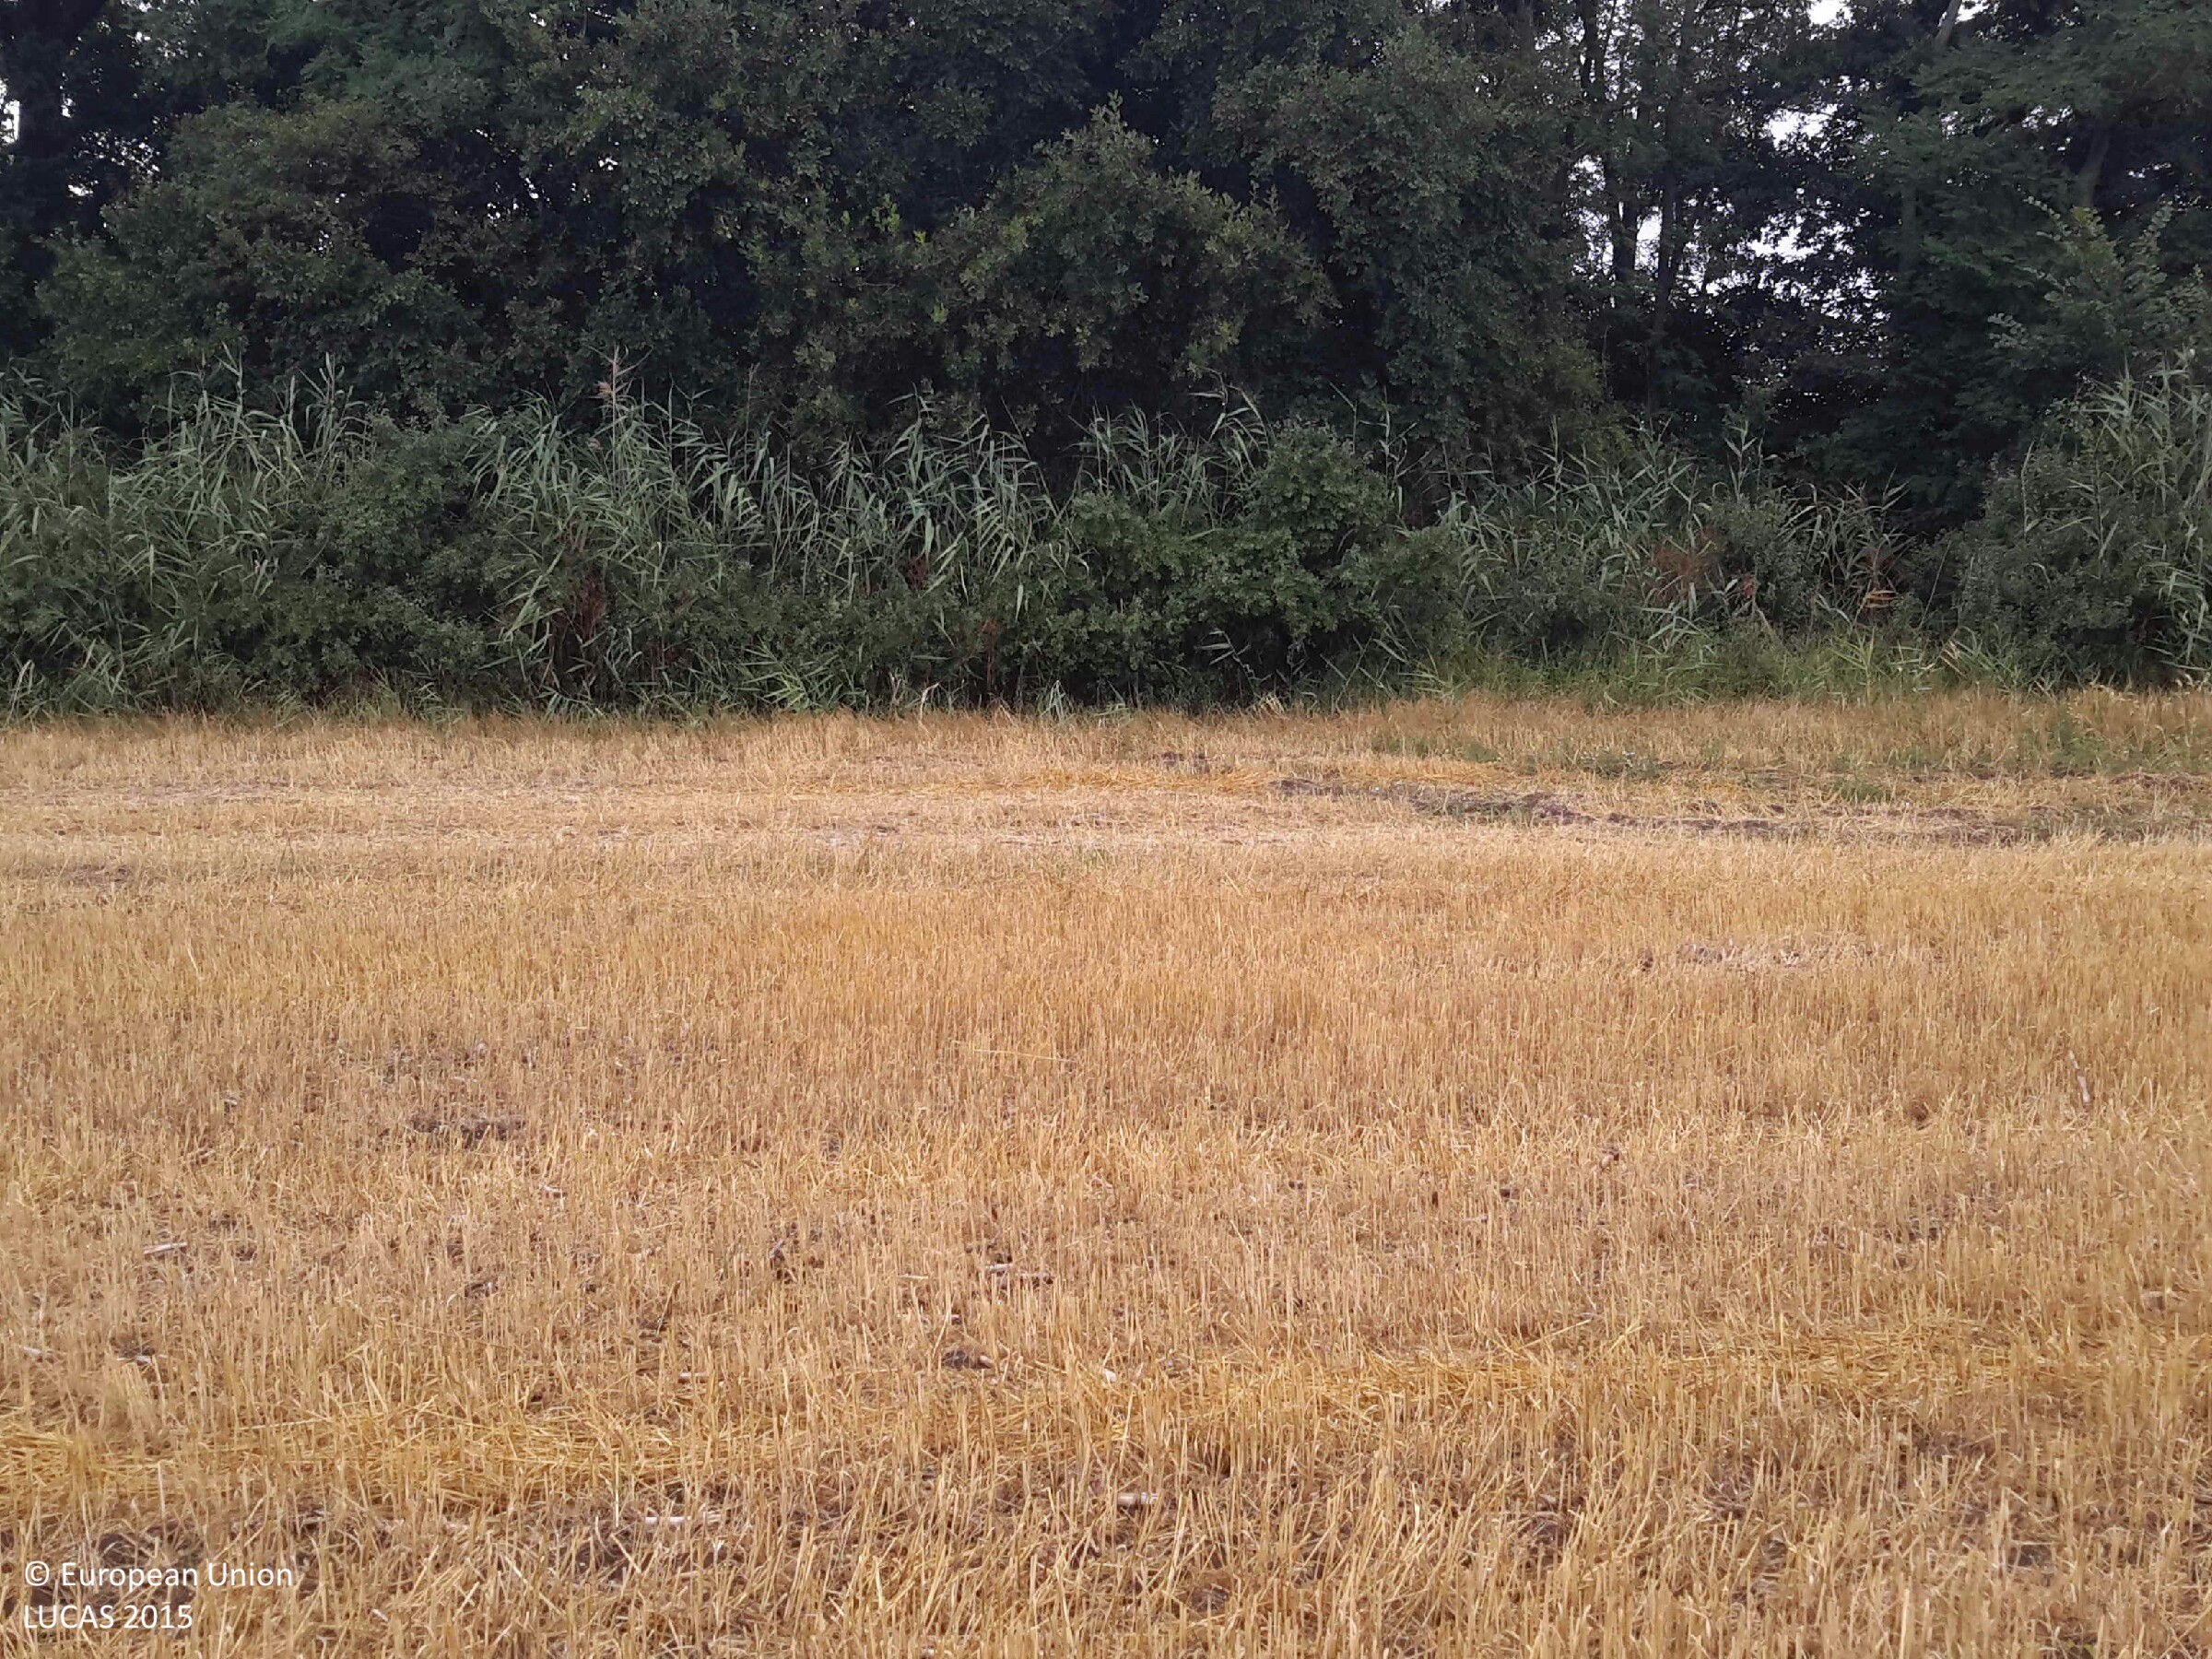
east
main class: Cropland
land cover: Common wheat
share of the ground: 50 - 75 %
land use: Agriculture (excluding fallow land and kitchen gardens)
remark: Harvested field
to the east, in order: Common wheat; Tracks; Shrubland with sparse tree cover; Broadleaved woodland; Shrubland with sparse tree cover; Sunflower
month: July
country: HU
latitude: 47.5226
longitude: 17.4051
